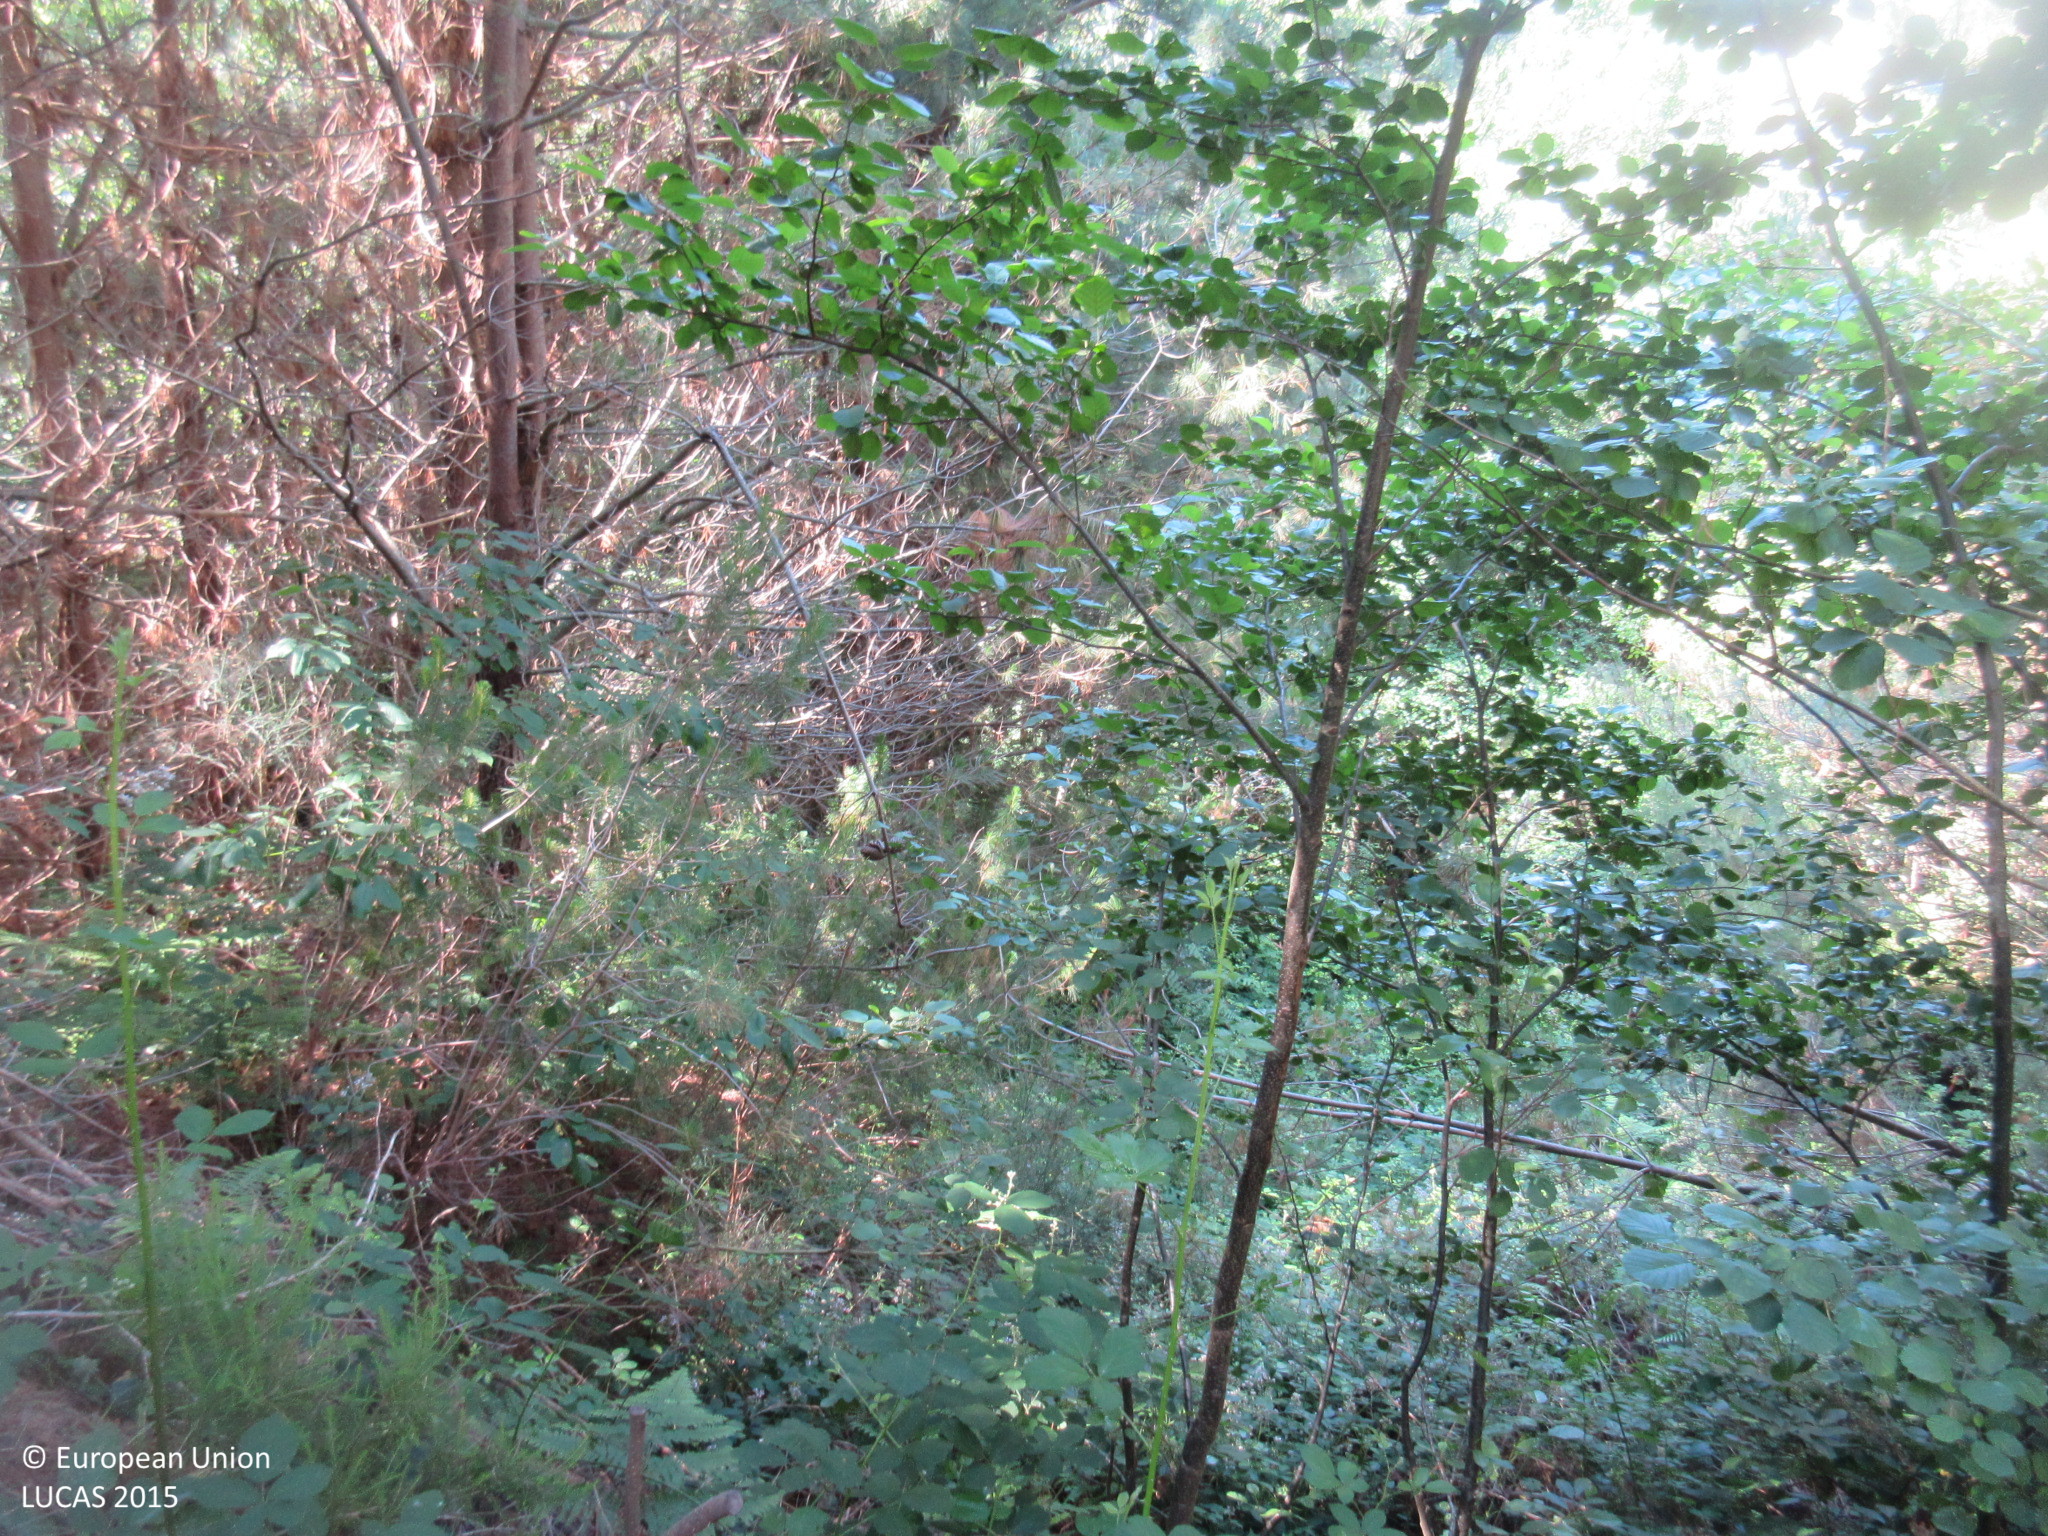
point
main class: Woodland
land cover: Pine dominated mixed woodland
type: hemiboreal forest and nemoral coniferous forest and mixed broadleaved-coniferous forest
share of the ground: > 75 %
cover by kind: coniferous forest trees 55 %, shrubs 25 %, broadleaved forest trees 20 %
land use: Forestry
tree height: > 5 m
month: June
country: ES
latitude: 42.8853
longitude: -6.9689
